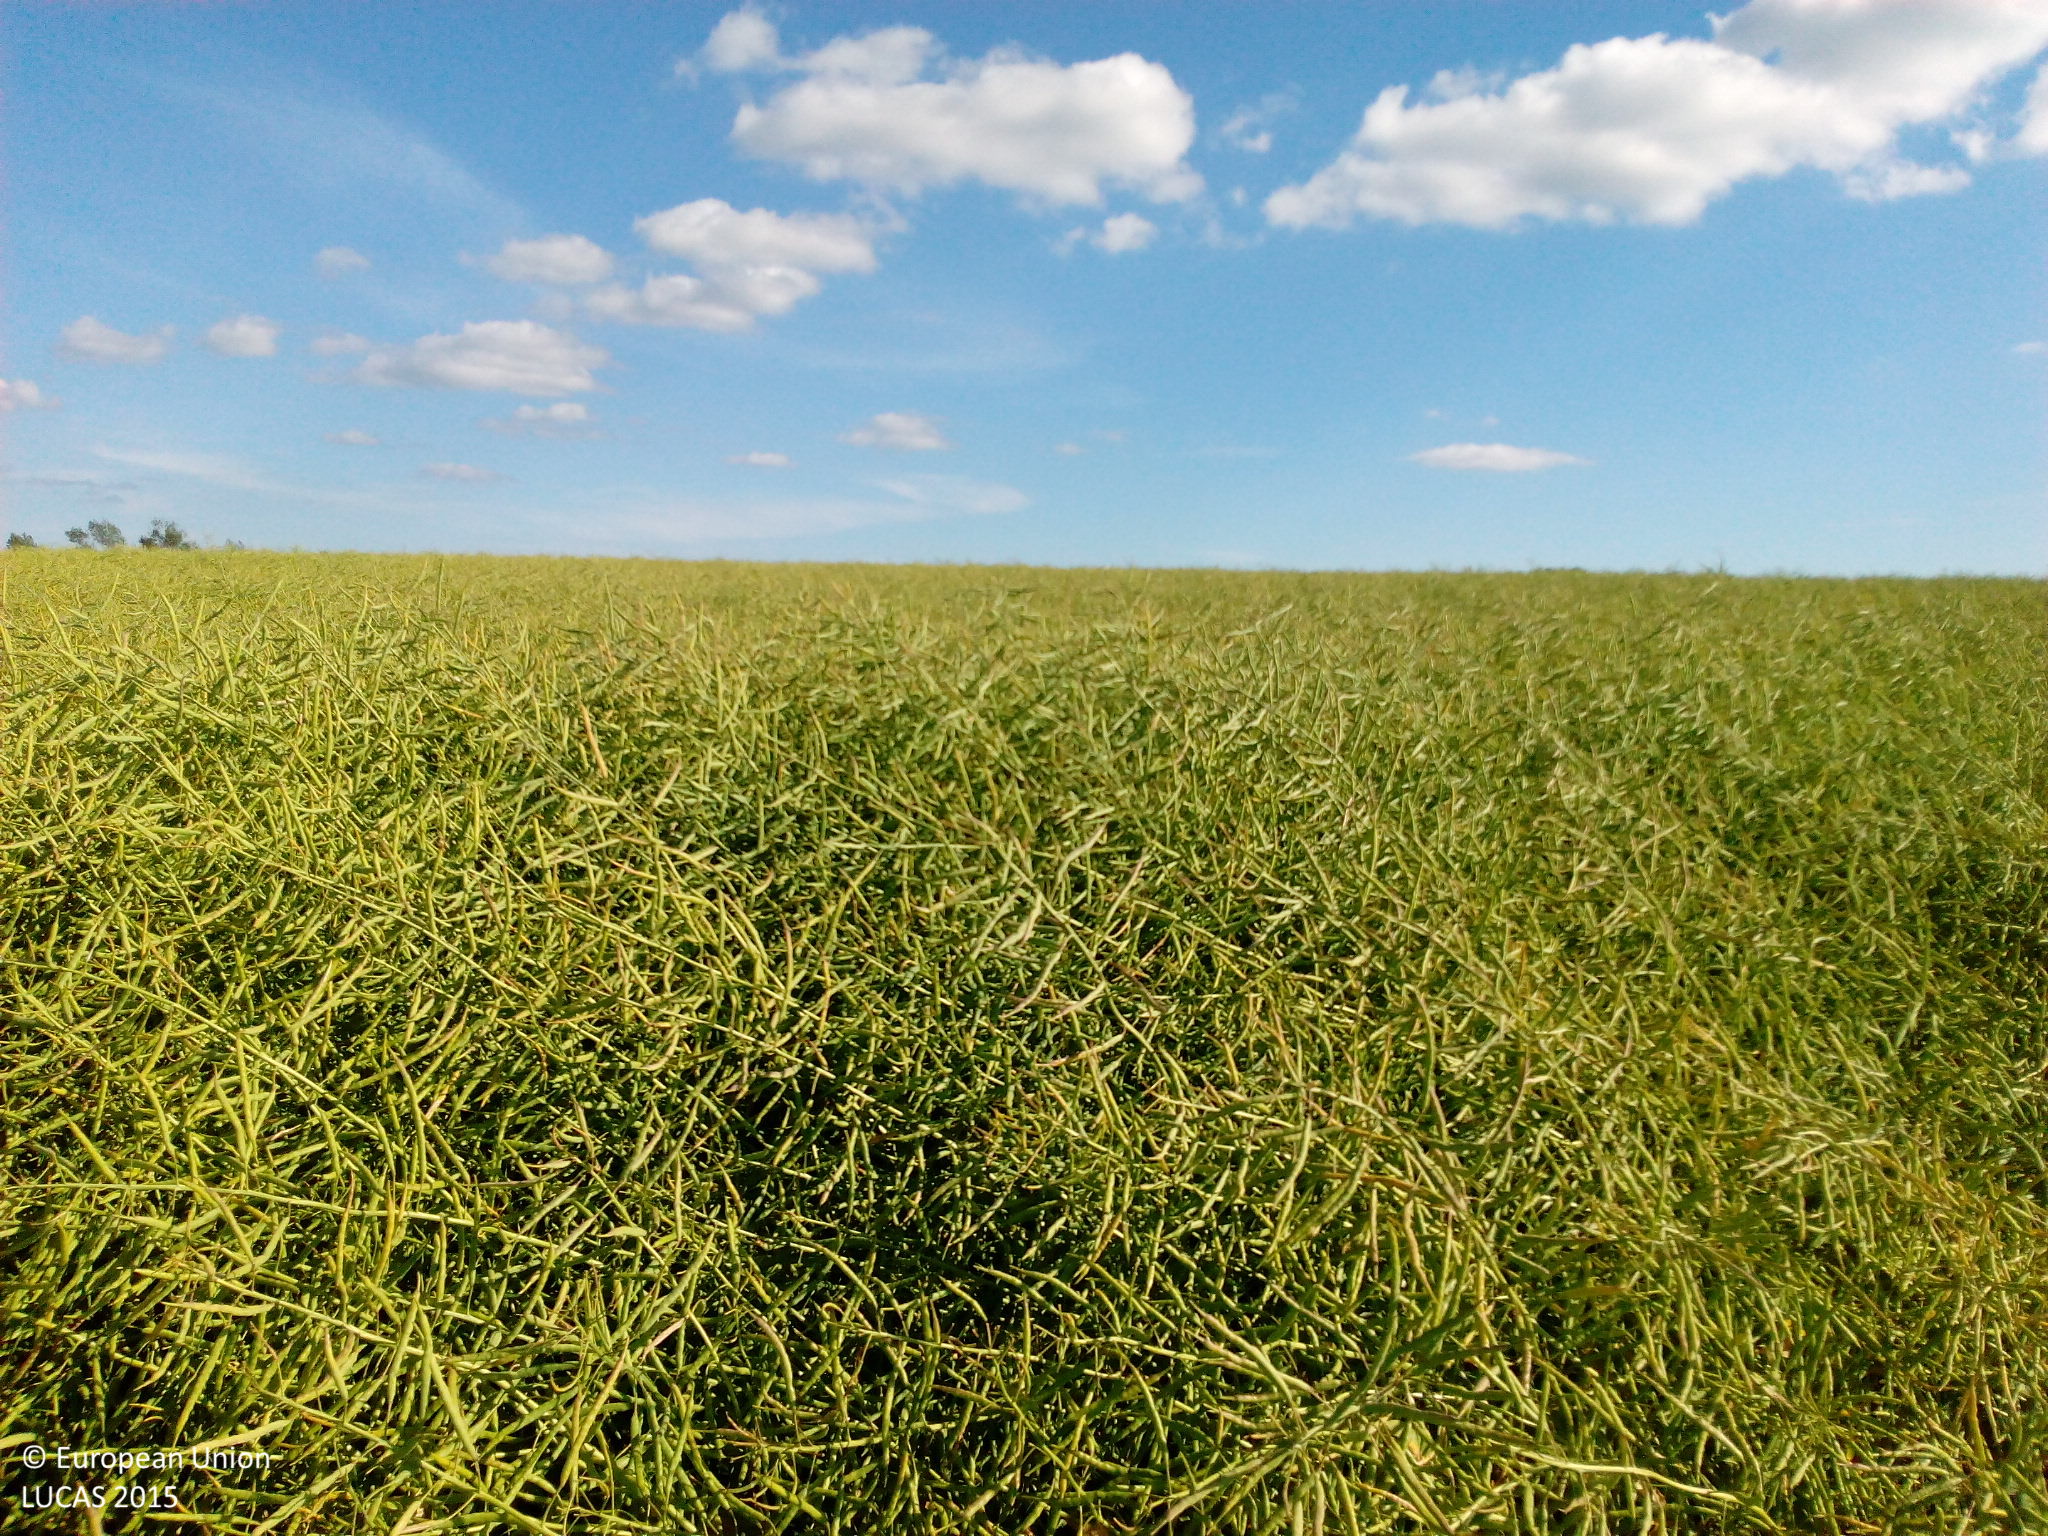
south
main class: Cropland
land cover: Rape and turnip rape
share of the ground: > 75 %
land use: Agriculture (excluding fallow land and kitchen gardens)
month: June
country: DK
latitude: 56.3298
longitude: 10.6623
